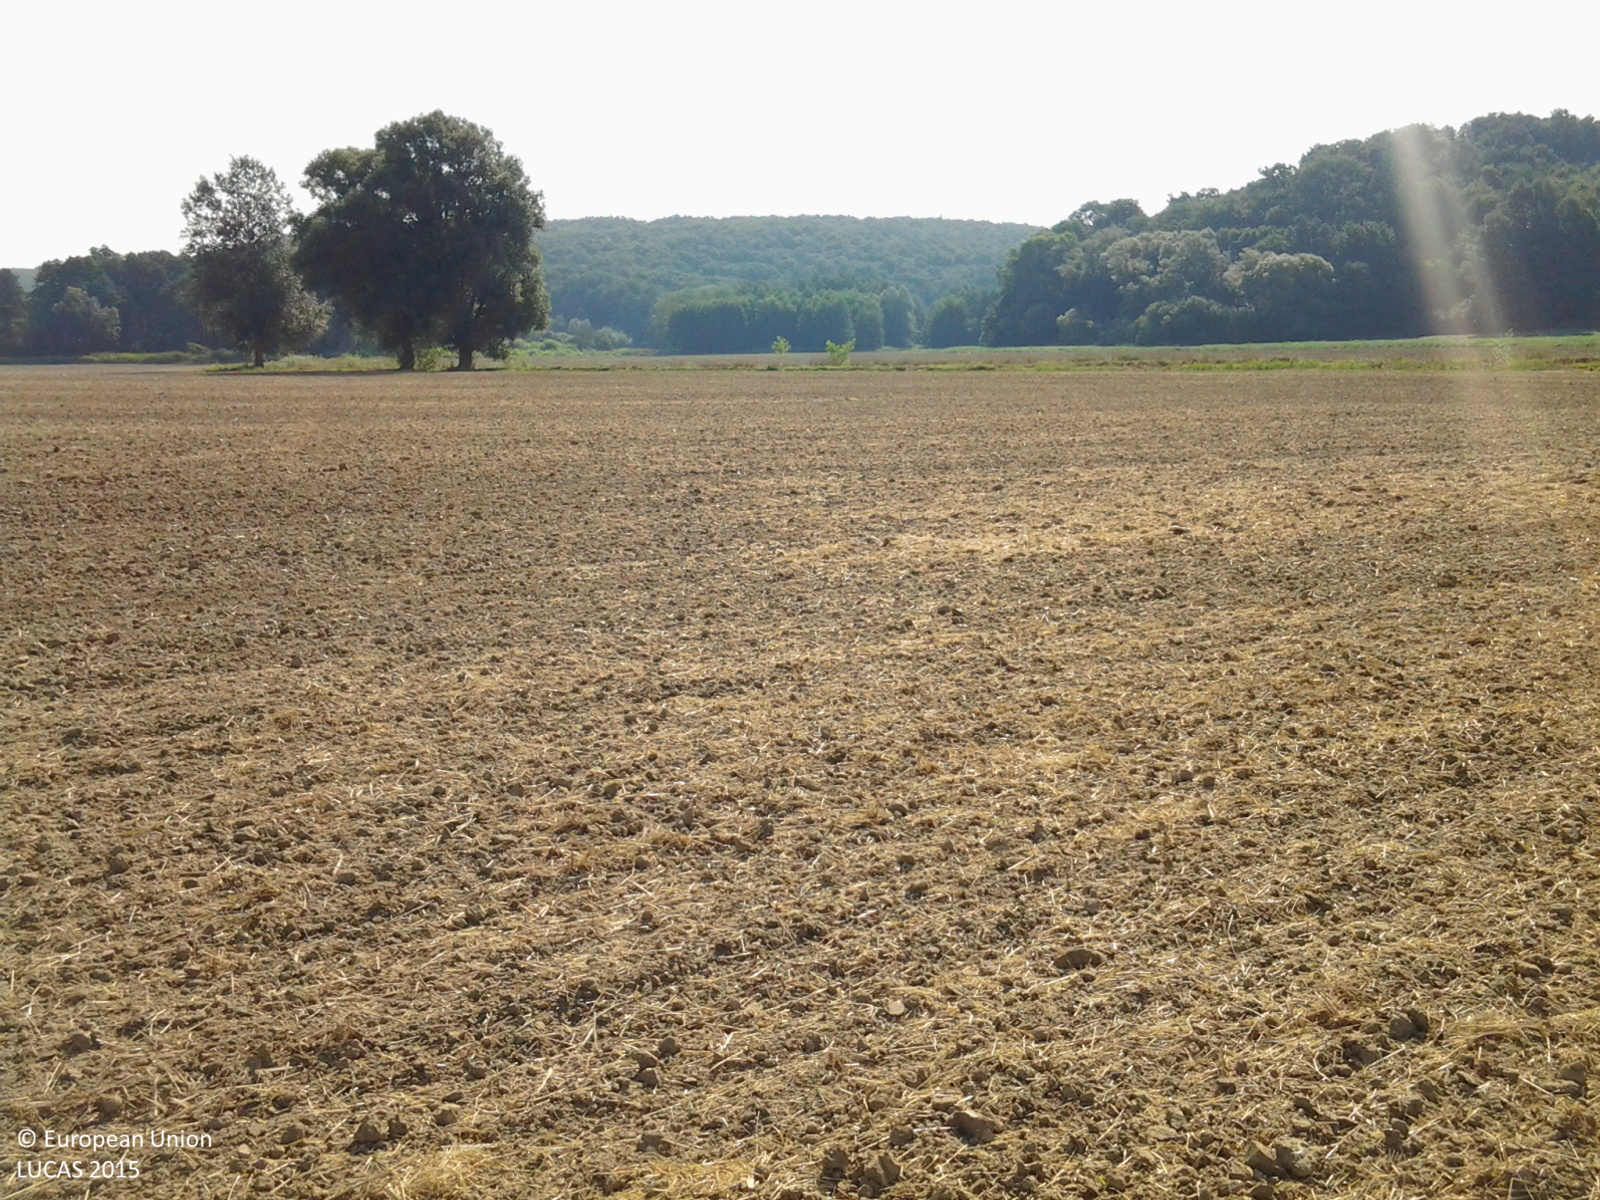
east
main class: Cropland
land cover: Oats
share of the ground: < 10 %
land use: Agriculture (excluding fallow land and kitchen gardens)
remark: Harvested field
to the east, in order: Oats; Tracks; Grass margins; Ditches and canals; Grass margins; Tracks; Rape and turnip rape
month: August
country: HU
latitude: 46.6054
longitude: 17.0664
